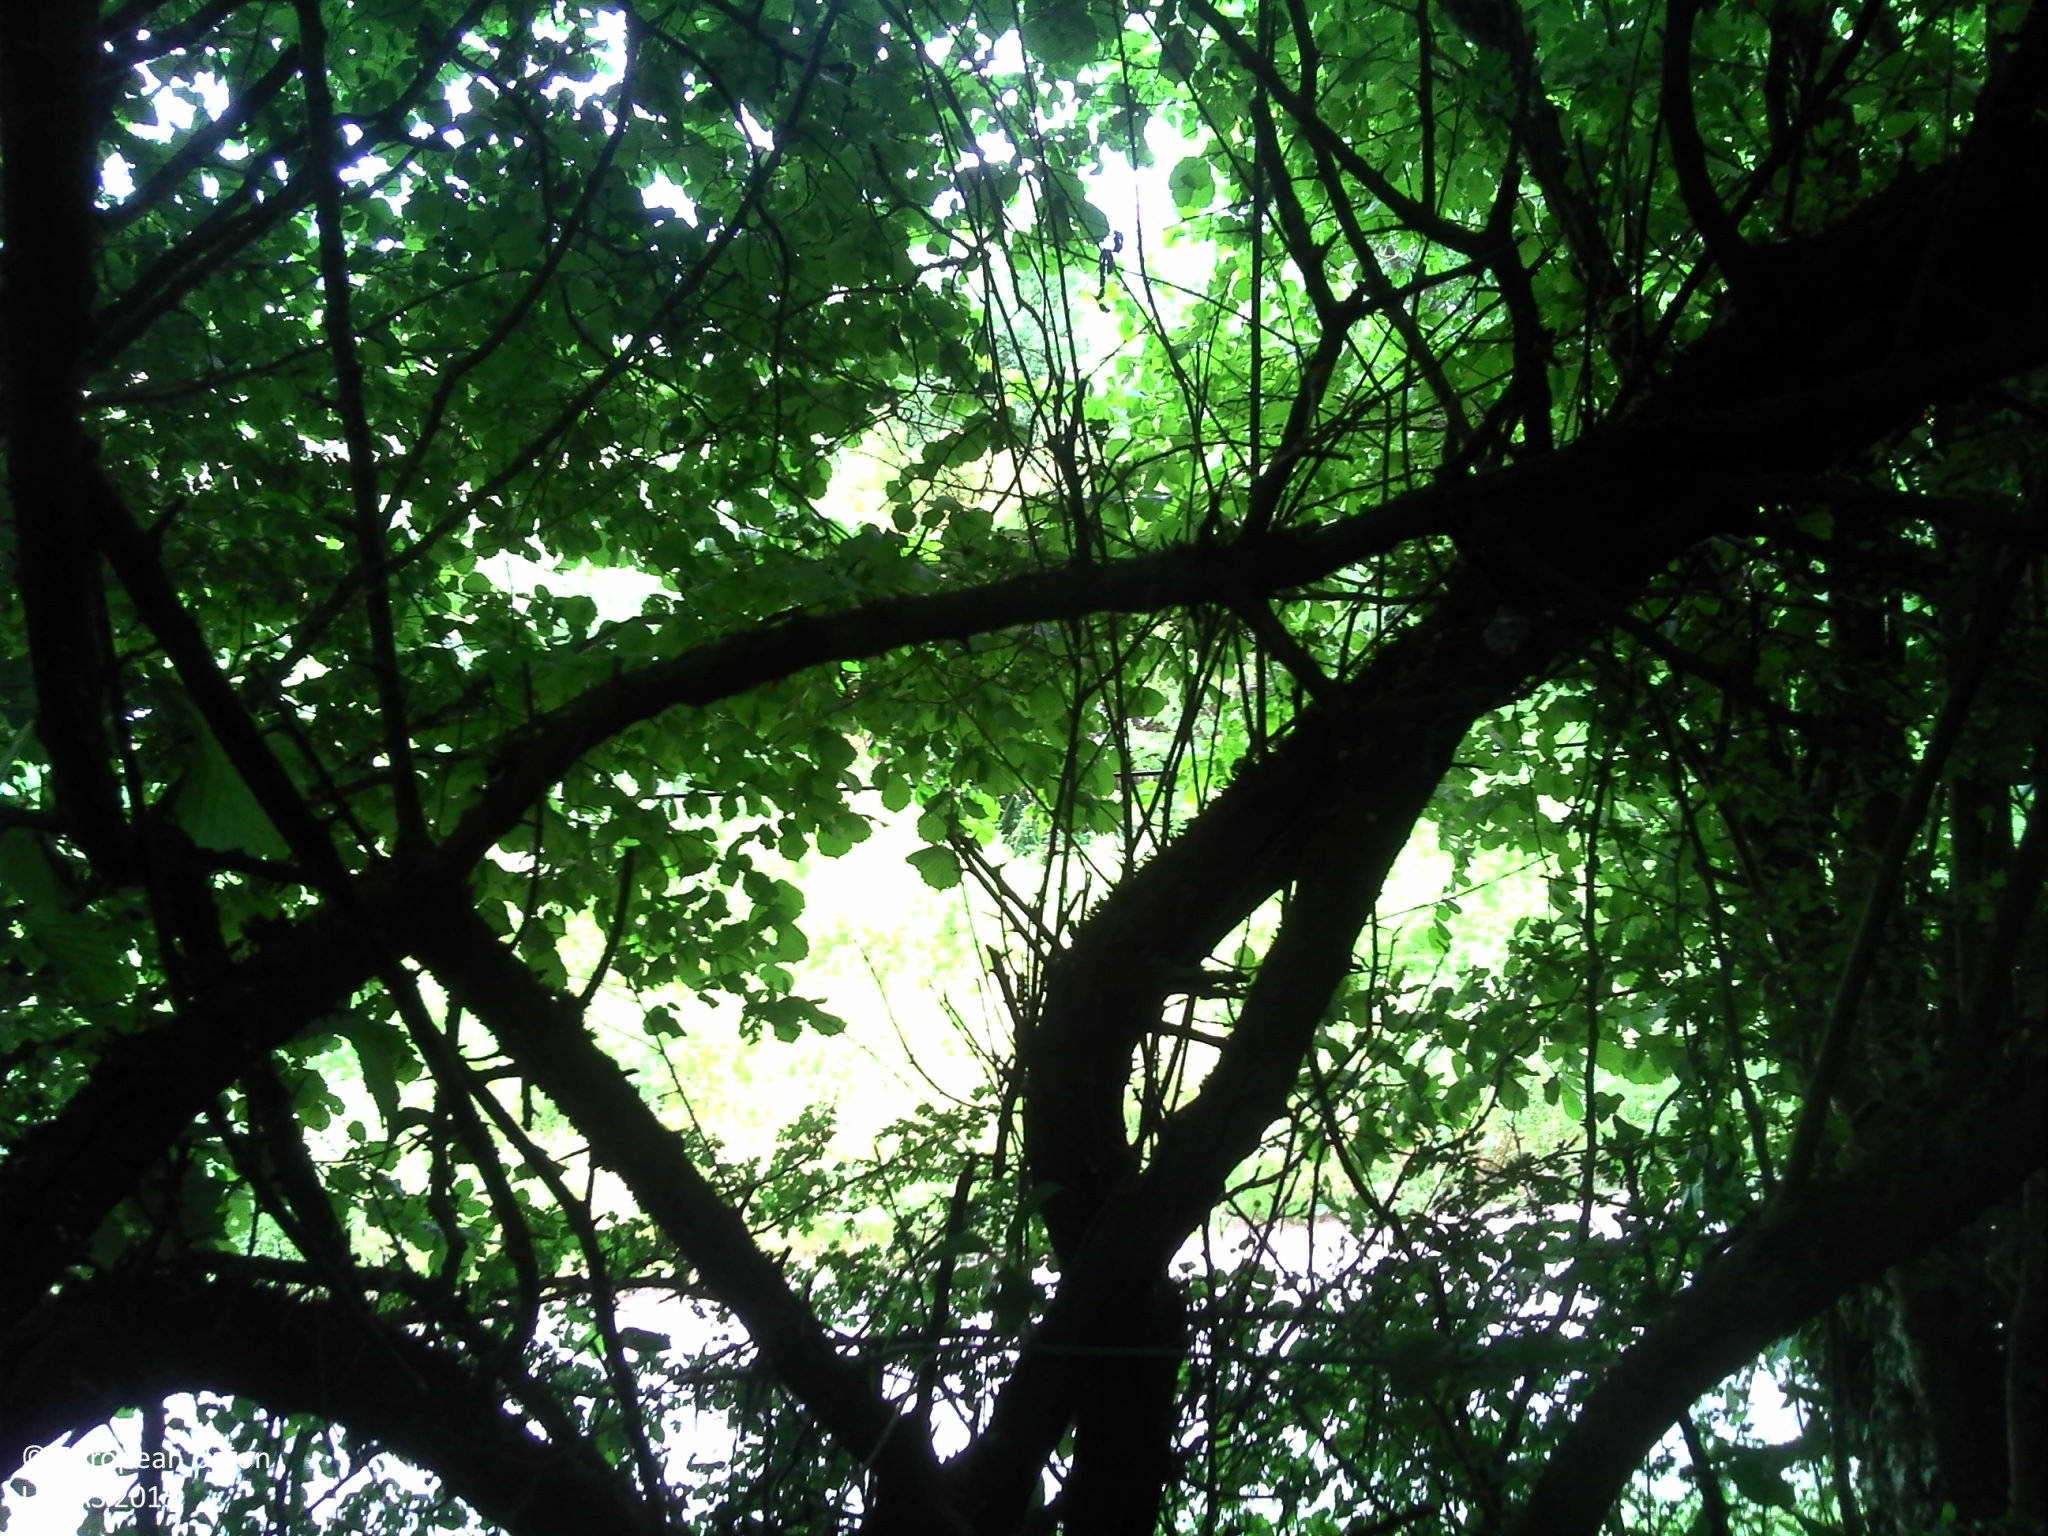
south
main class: Woodland
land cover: Broadleaved woodland
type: mesophytic deciduous forest
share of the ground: > 75 %
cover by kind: broadleaved forest trees 100 %
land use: Forestry
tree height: > 5 m
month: June
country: FR
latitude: 47.4903
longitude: 7.3870
